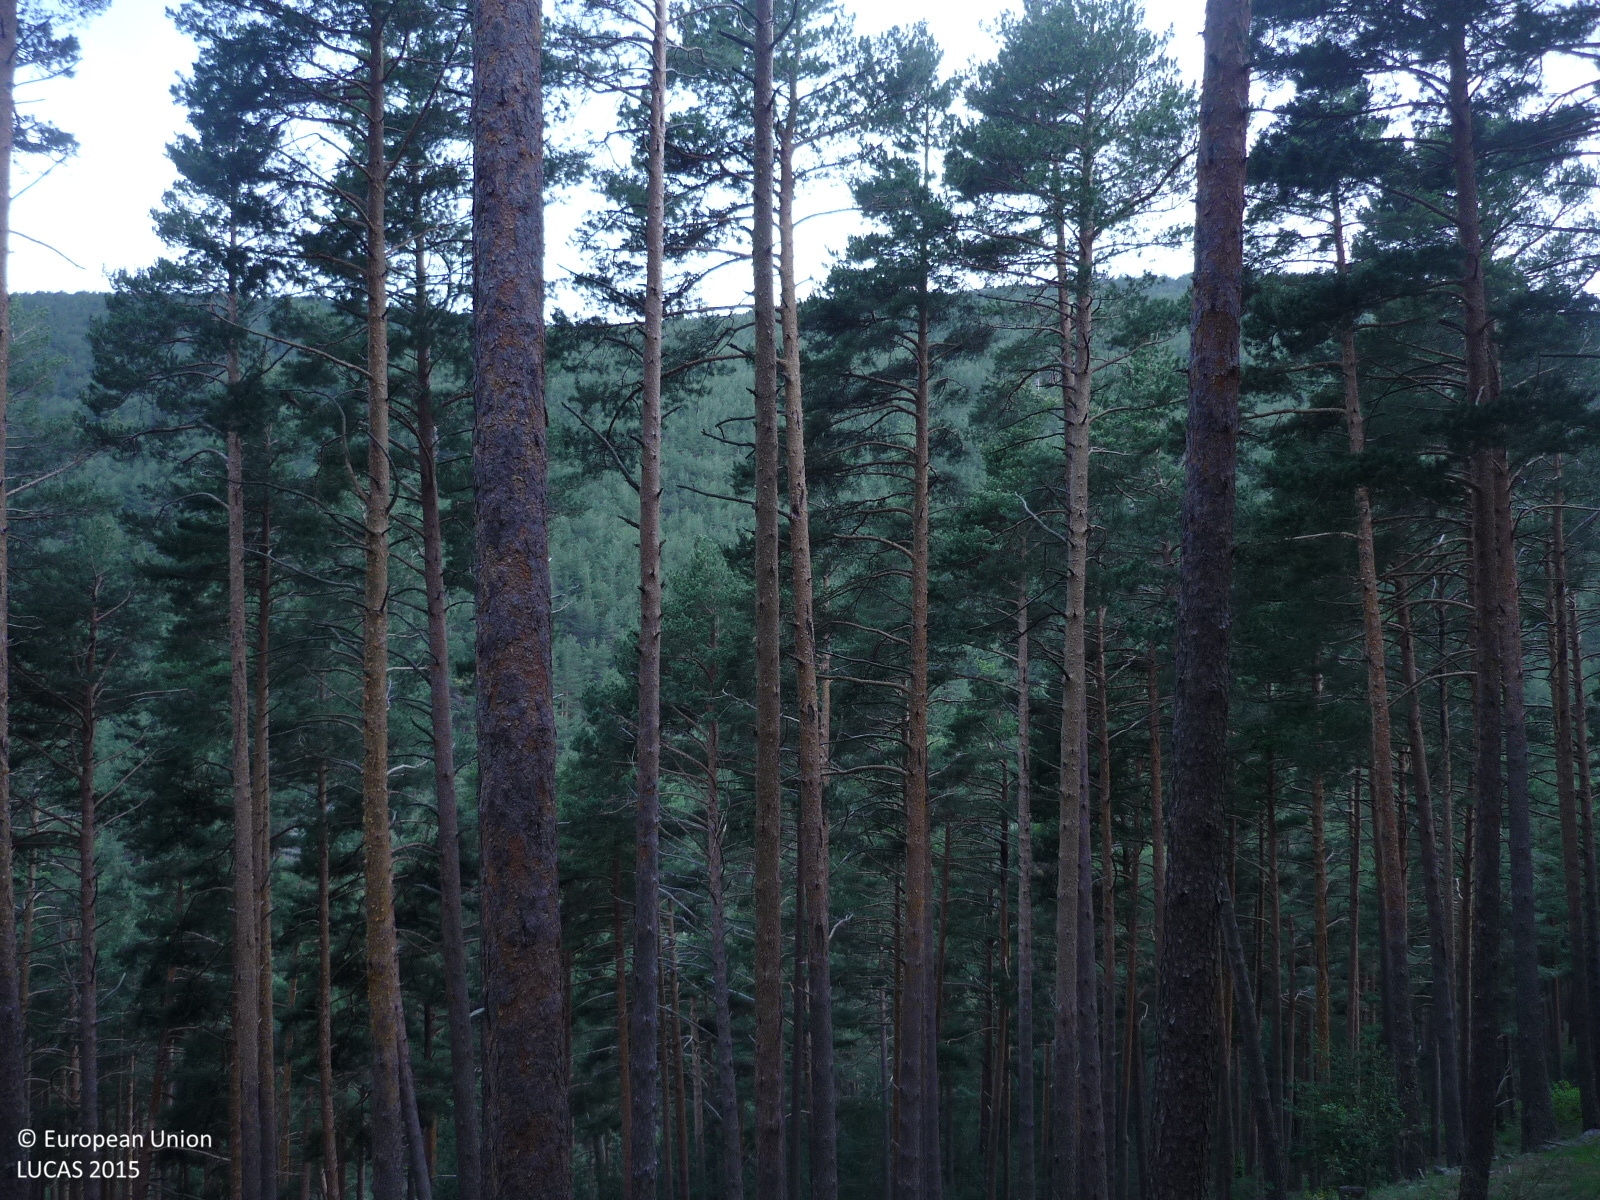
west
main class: Woodland
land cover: Pine dominated coniferous woodland
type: coniferous forest of the mediterranean region
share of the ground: > 75 %
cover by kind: coniferous forest trees 85 %, shrubs 10 %, herbaceous plants 5 %
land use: Forestry
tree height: > 5 m
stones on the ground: 10 - 25 %
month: May
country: ES
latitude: 41.0635
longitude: -3.6707
